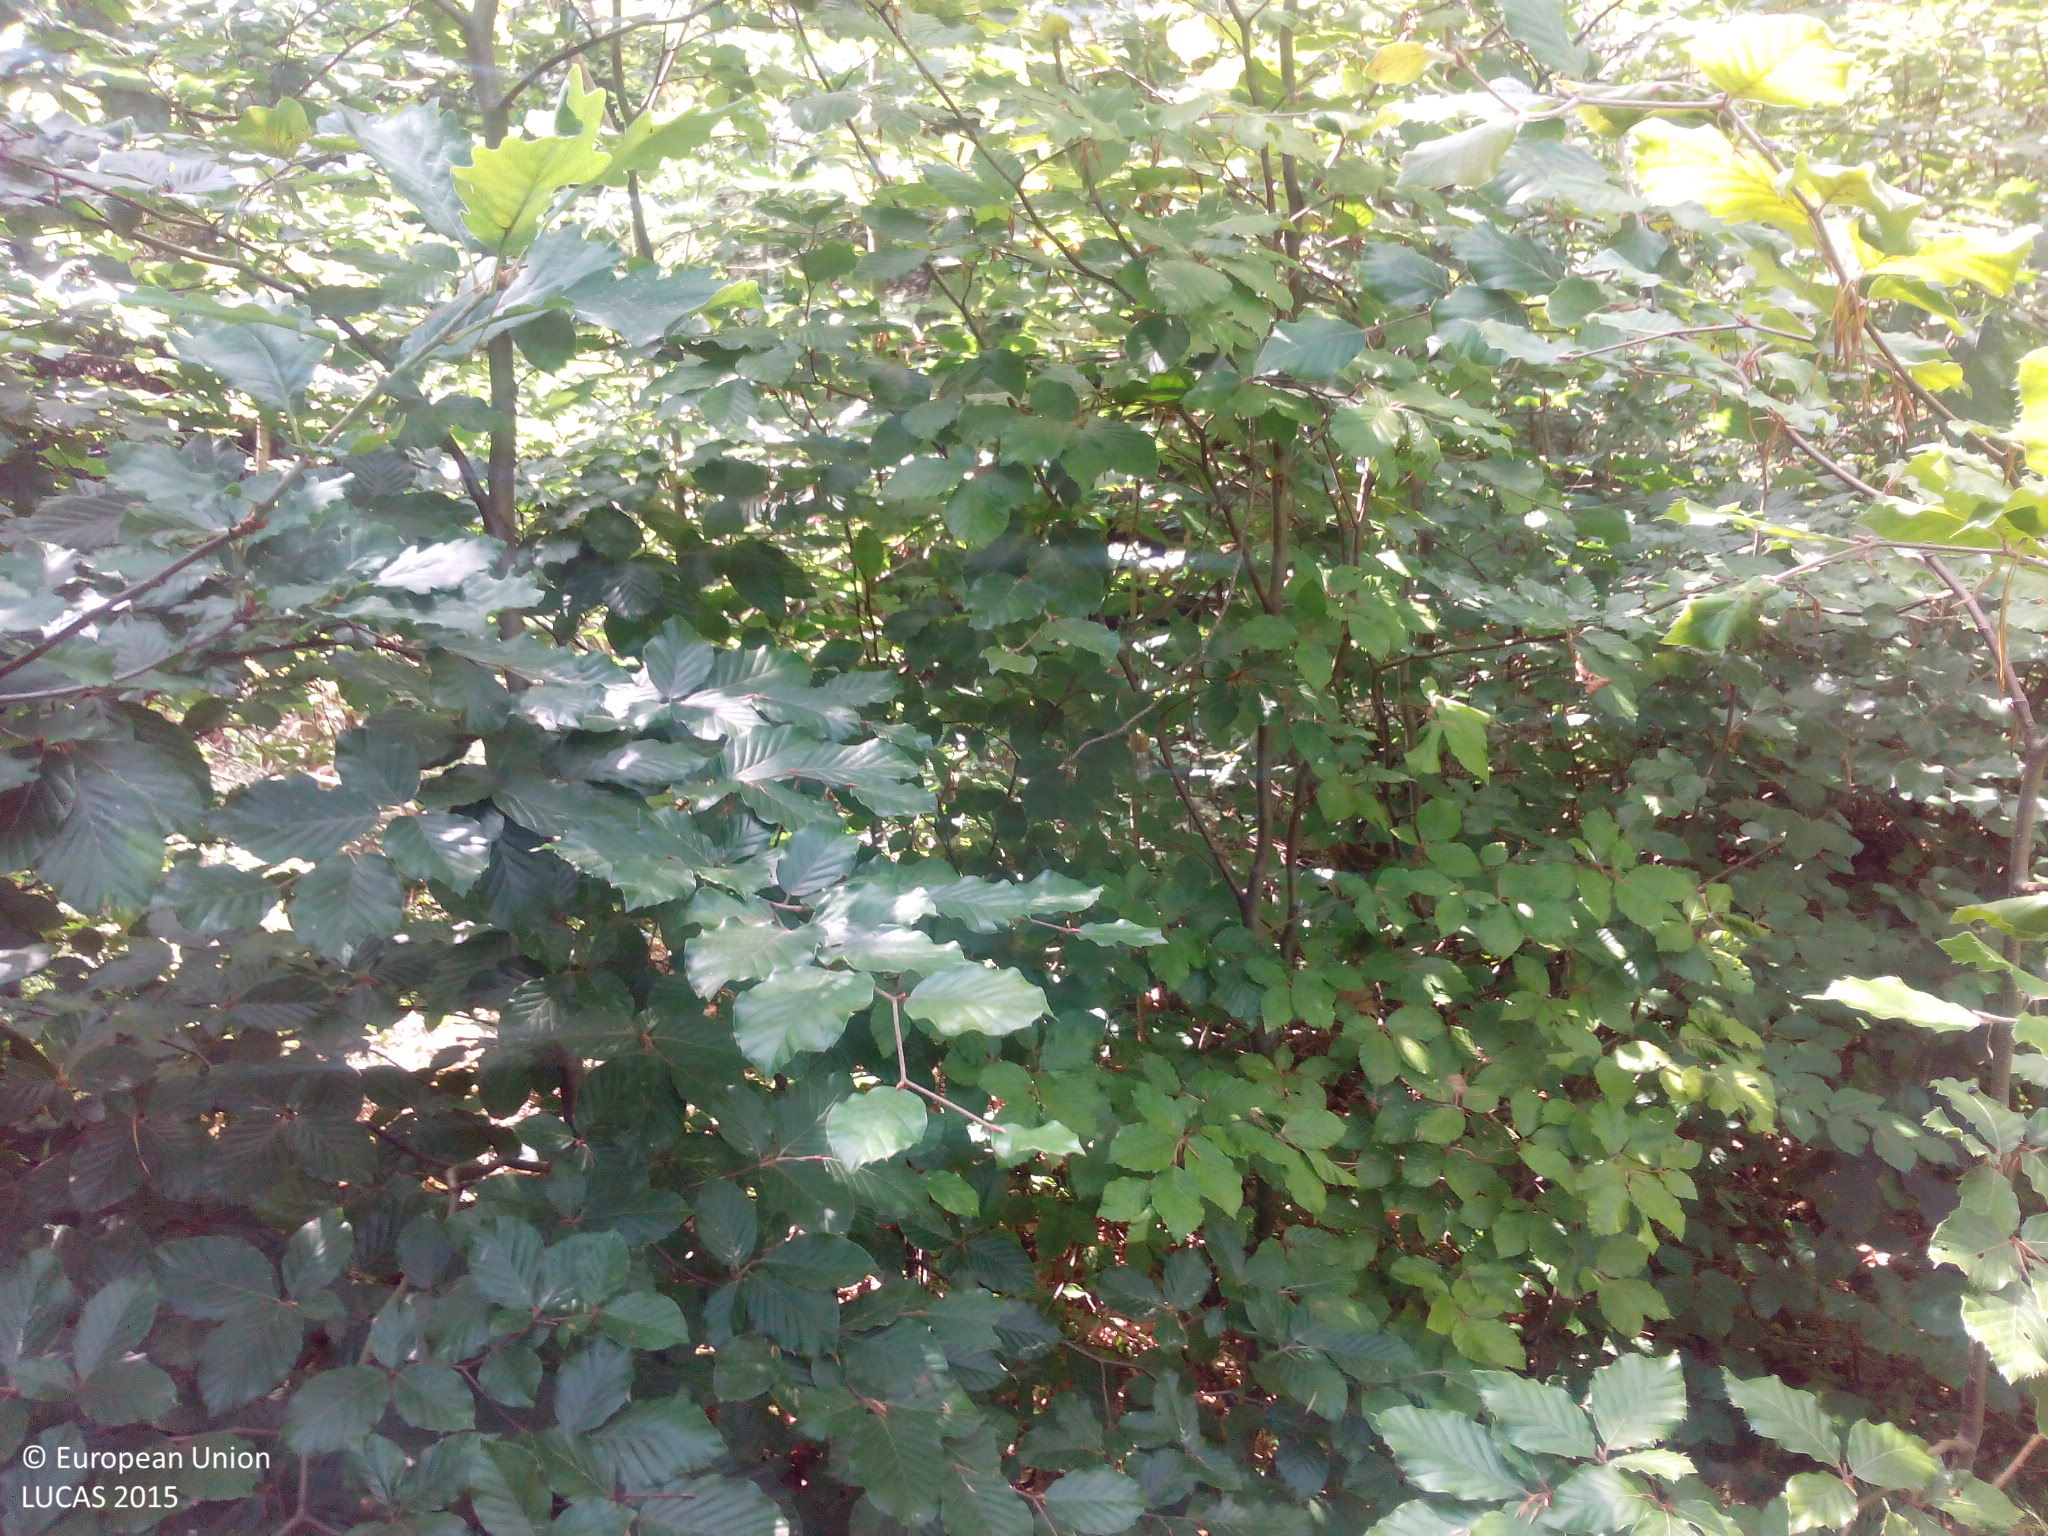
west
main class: Woodland
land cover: Pine dominated mixed woodland
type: hemiboreal forest and nemoral coniferous forest and mixed broadleaved-coniferous forest
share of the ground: > 75 %
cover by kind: broadleaved forest trees 45 %, coniferous forest trees 35 %, shrubs 10 %, lichens and mosses 10 %
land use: Forestry
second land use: Amenities, museums, leisure
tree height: > 5 m
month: July
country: DE
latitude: 49.6771
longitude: 10.9005
